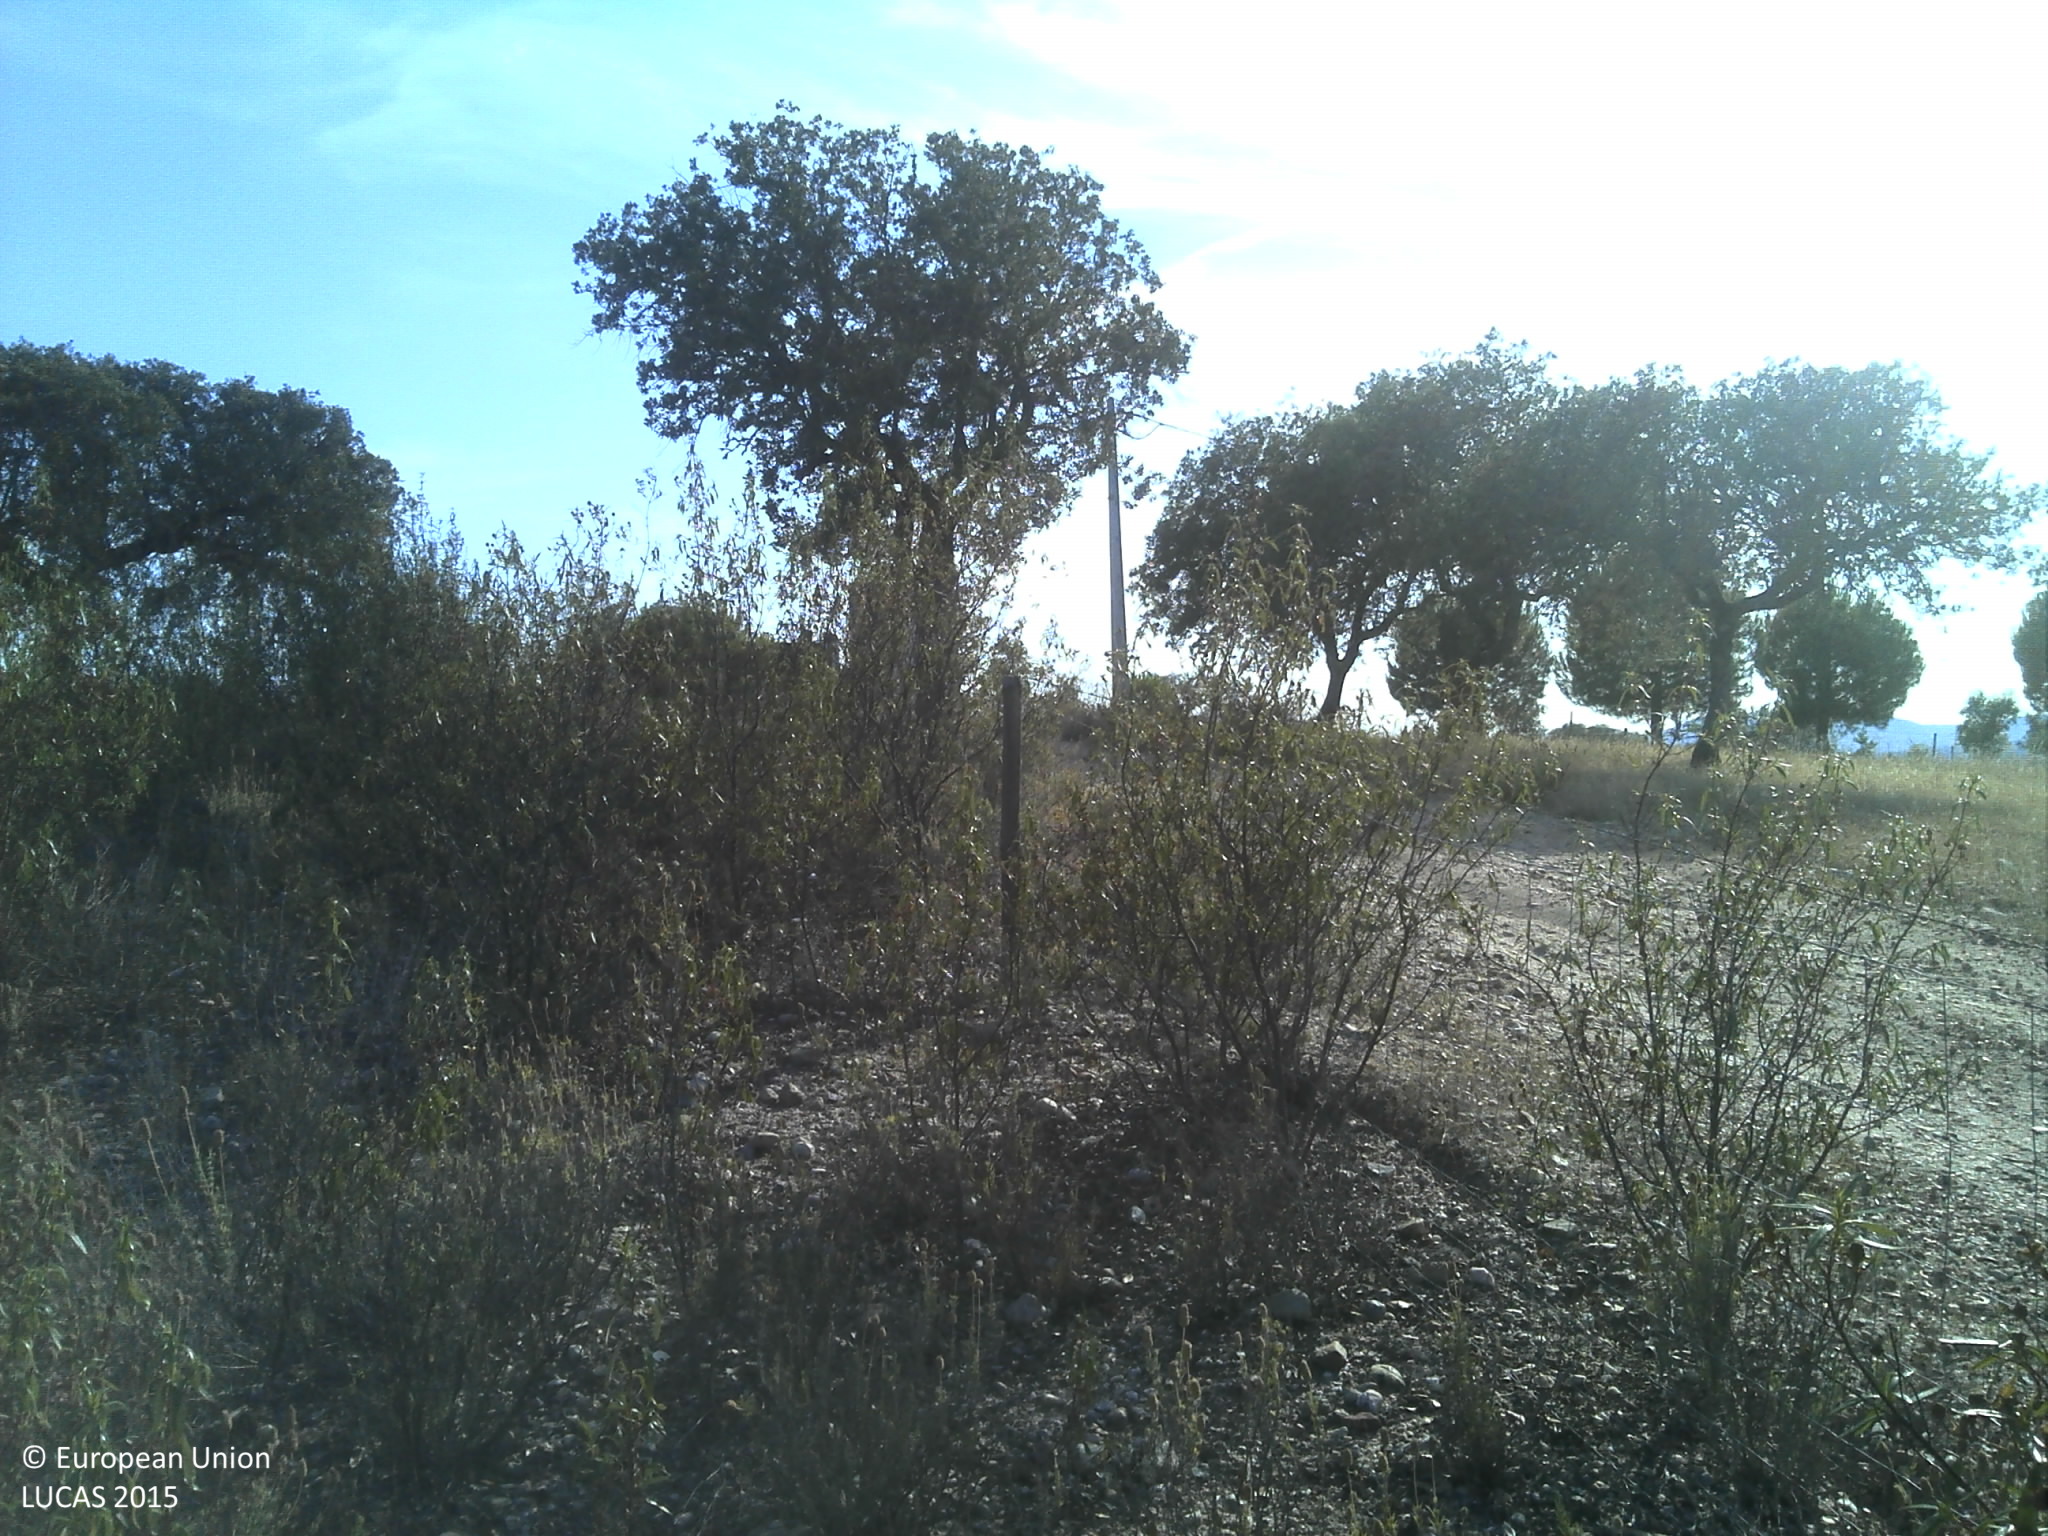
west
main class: Woodland
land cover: Broadleaved woodland
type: broadleaved evergreen forest
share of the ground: 10 - 25 %
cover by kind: unconsolidated bare surface 60 %, broadleaved forest trees 20 %, shrubs 10 %, herbaceous plants 10 %
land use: Forestry
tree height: < 5 m
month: July
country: PT
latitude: 39.6945
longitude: -7.5077
